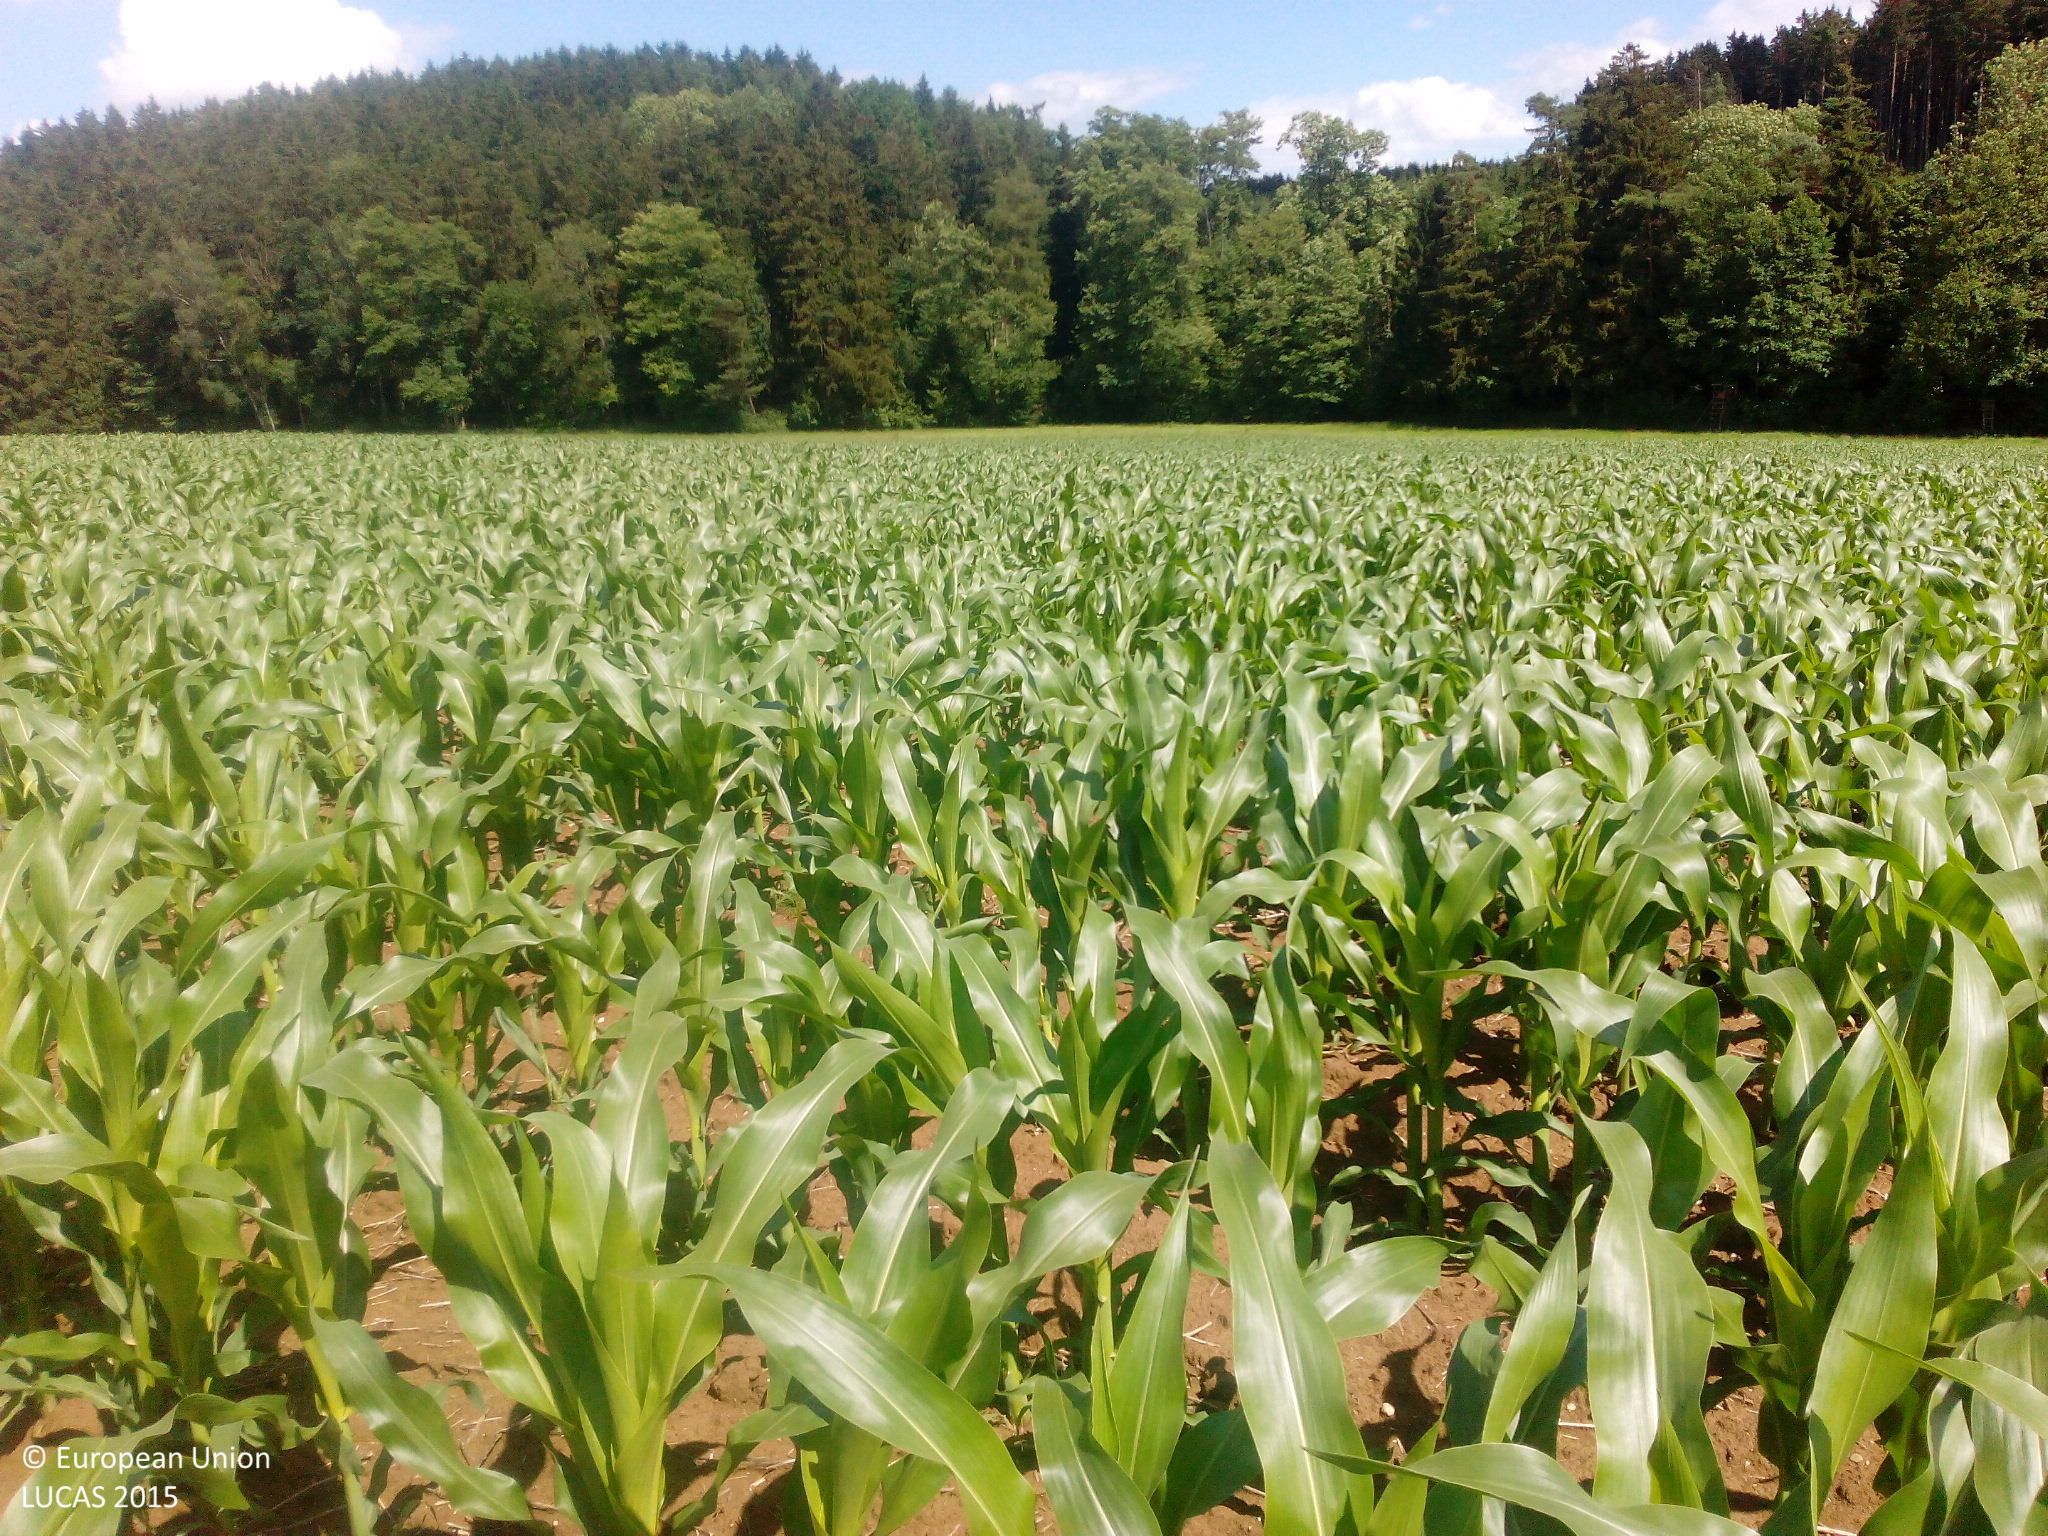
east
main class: Cropland
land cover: Maize
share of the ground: 25 - 50 %
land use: Agriculture (excluding fallow land and kitchen gardens)
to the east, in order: Maize; Grassland without tree/shrub cover; Spruce dominated mixed woodland; Tracks; Spruce dominated mixed woodland
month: June
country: DE
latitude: 48.6029
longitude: 11.9114
